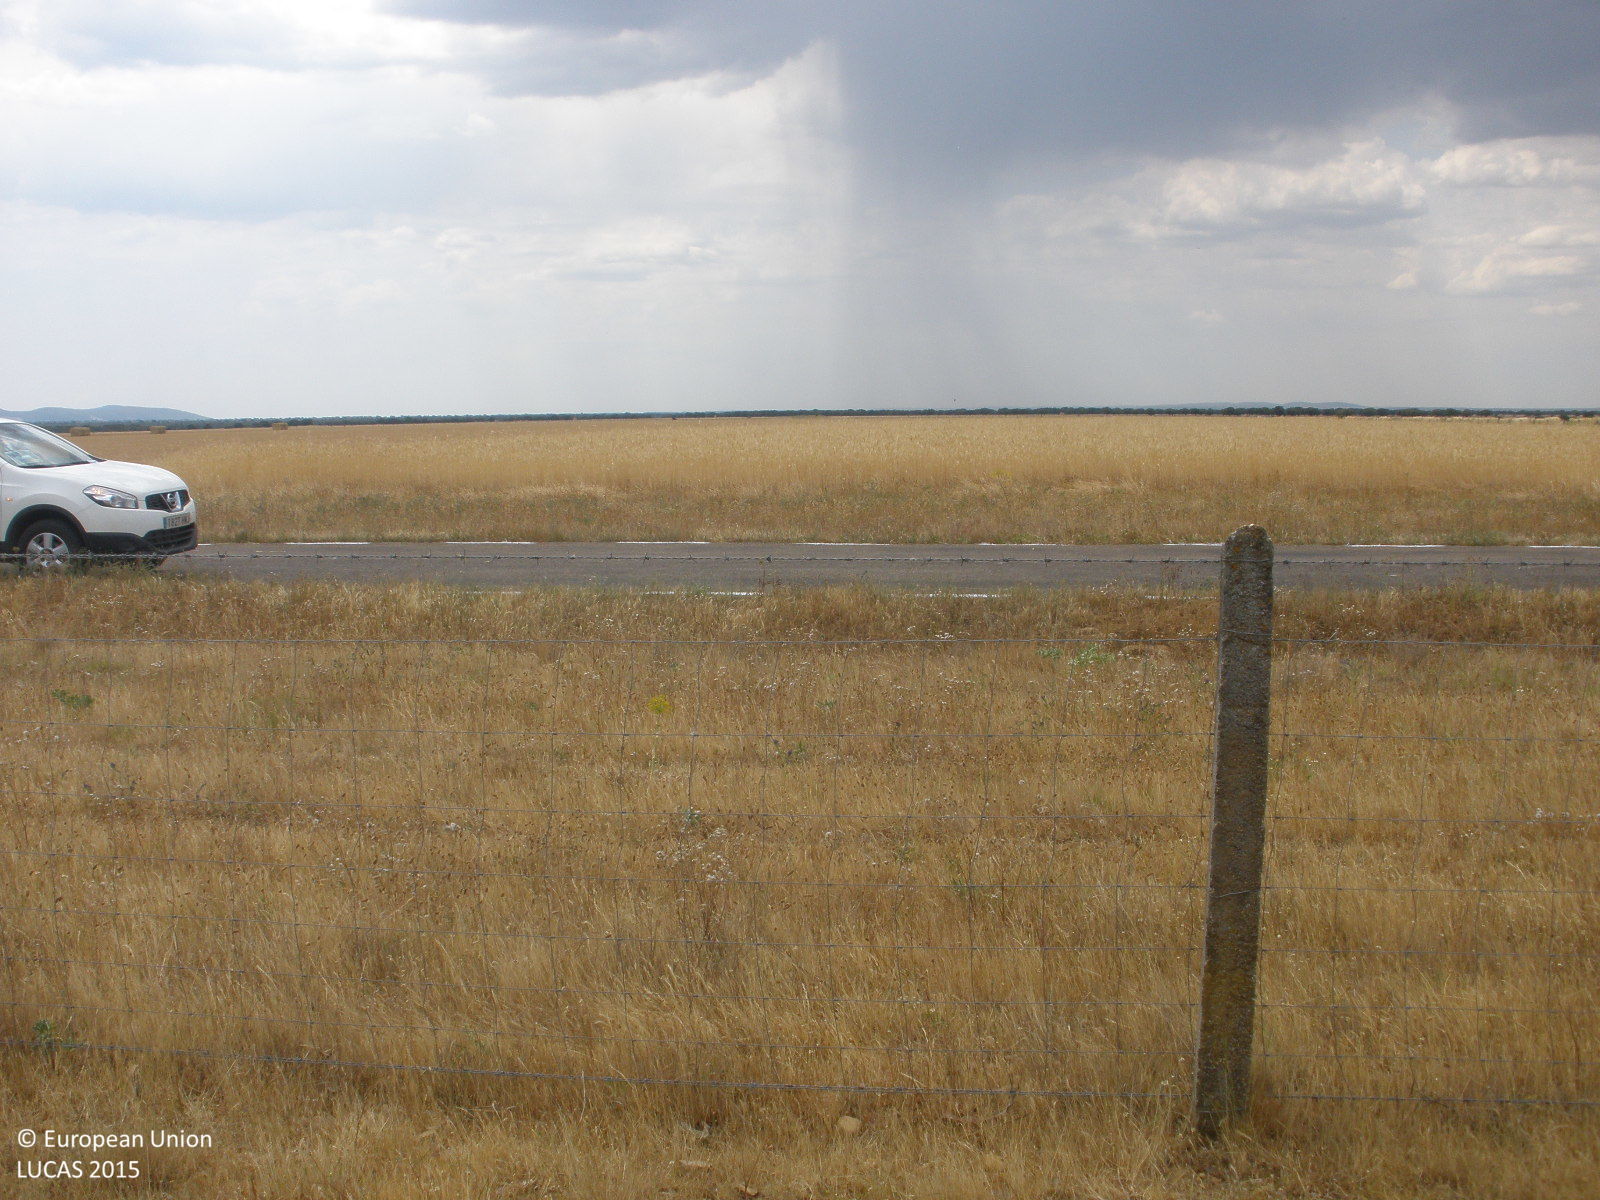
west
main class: Woodland
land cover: Broadleaved woodland
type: broadleaved evergreen forest
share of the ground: 25 - 50 %
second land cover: Grassland without tree/shrub cover
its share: > 75 %
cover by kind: herbaceous plants 70 %, broadleaved forest trees 30 %
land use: Forestry
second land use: Agriculture (excluding fallow land and kitchen gardens)
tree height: > 5 m
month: June
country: ES
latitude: 40.6447
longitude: -6.1770
